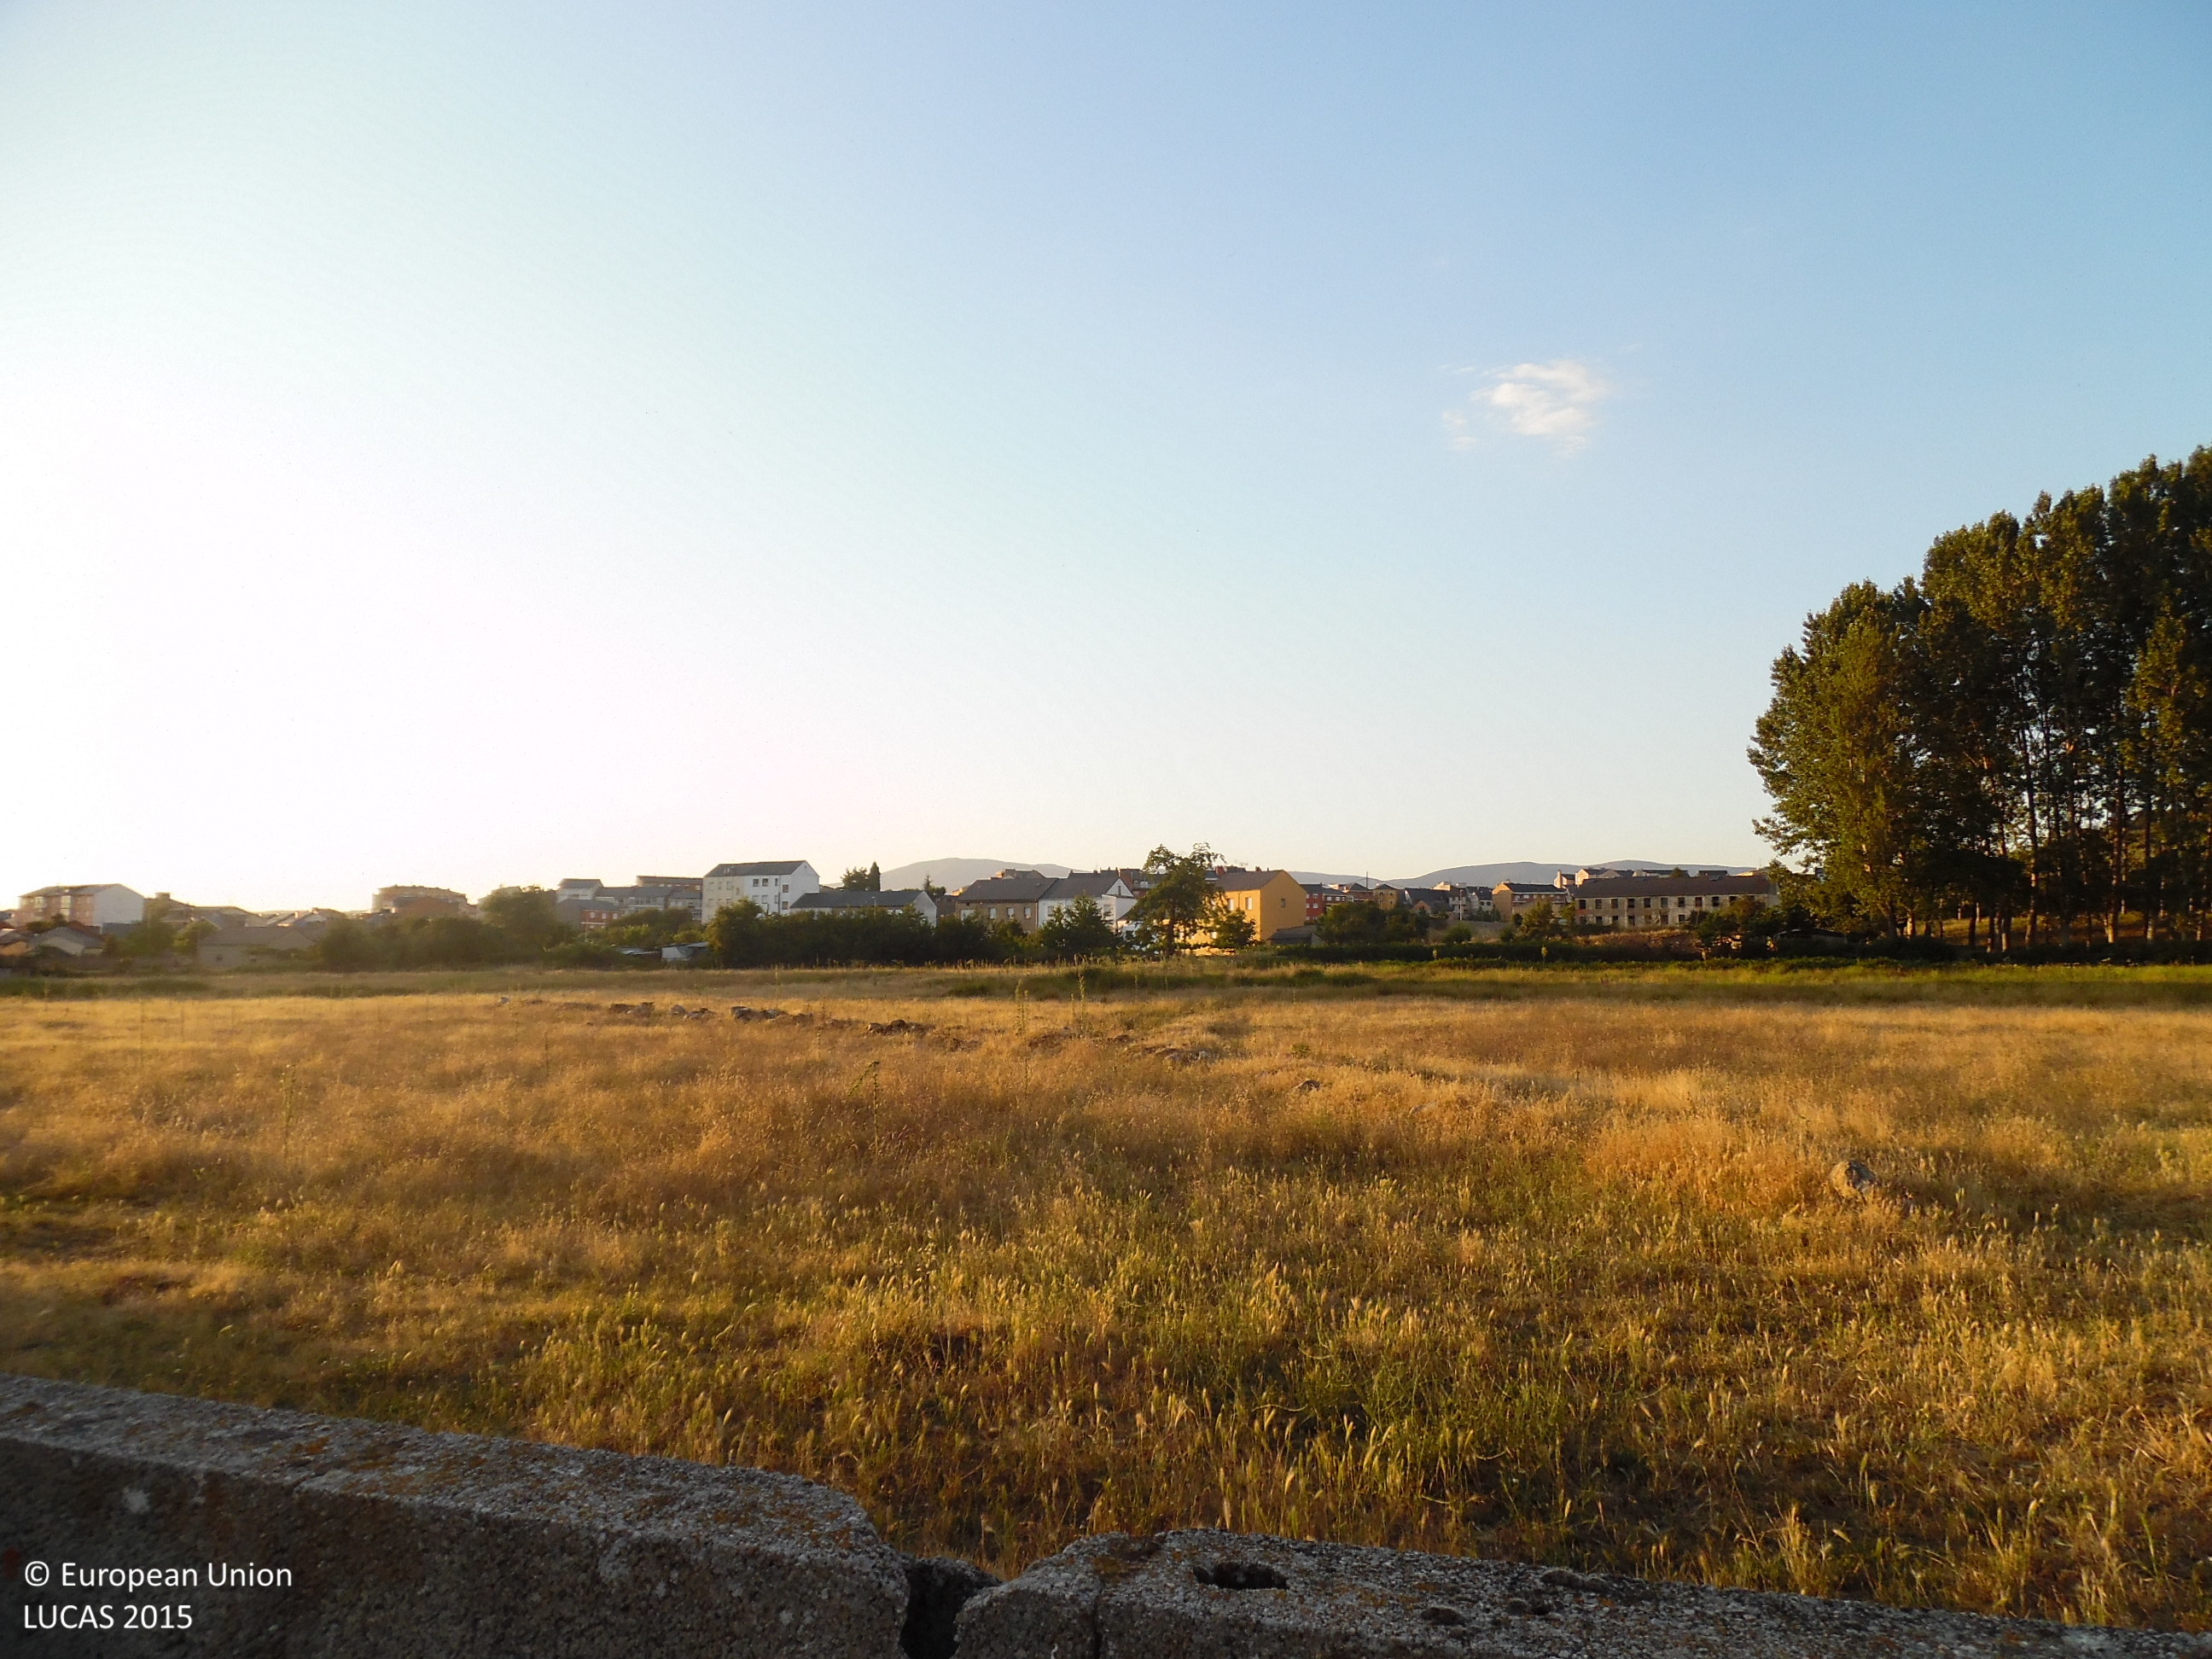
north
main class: Grassland
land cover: Grassland without tree/shrub cover
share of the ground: > 75 %
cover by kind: herbaceous plants 95 %, shrubs 5 %
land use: Agriculture (excluding fallow land and kitchen gardens)
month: June
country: ES
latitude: 42.6099
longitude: -6.4139
